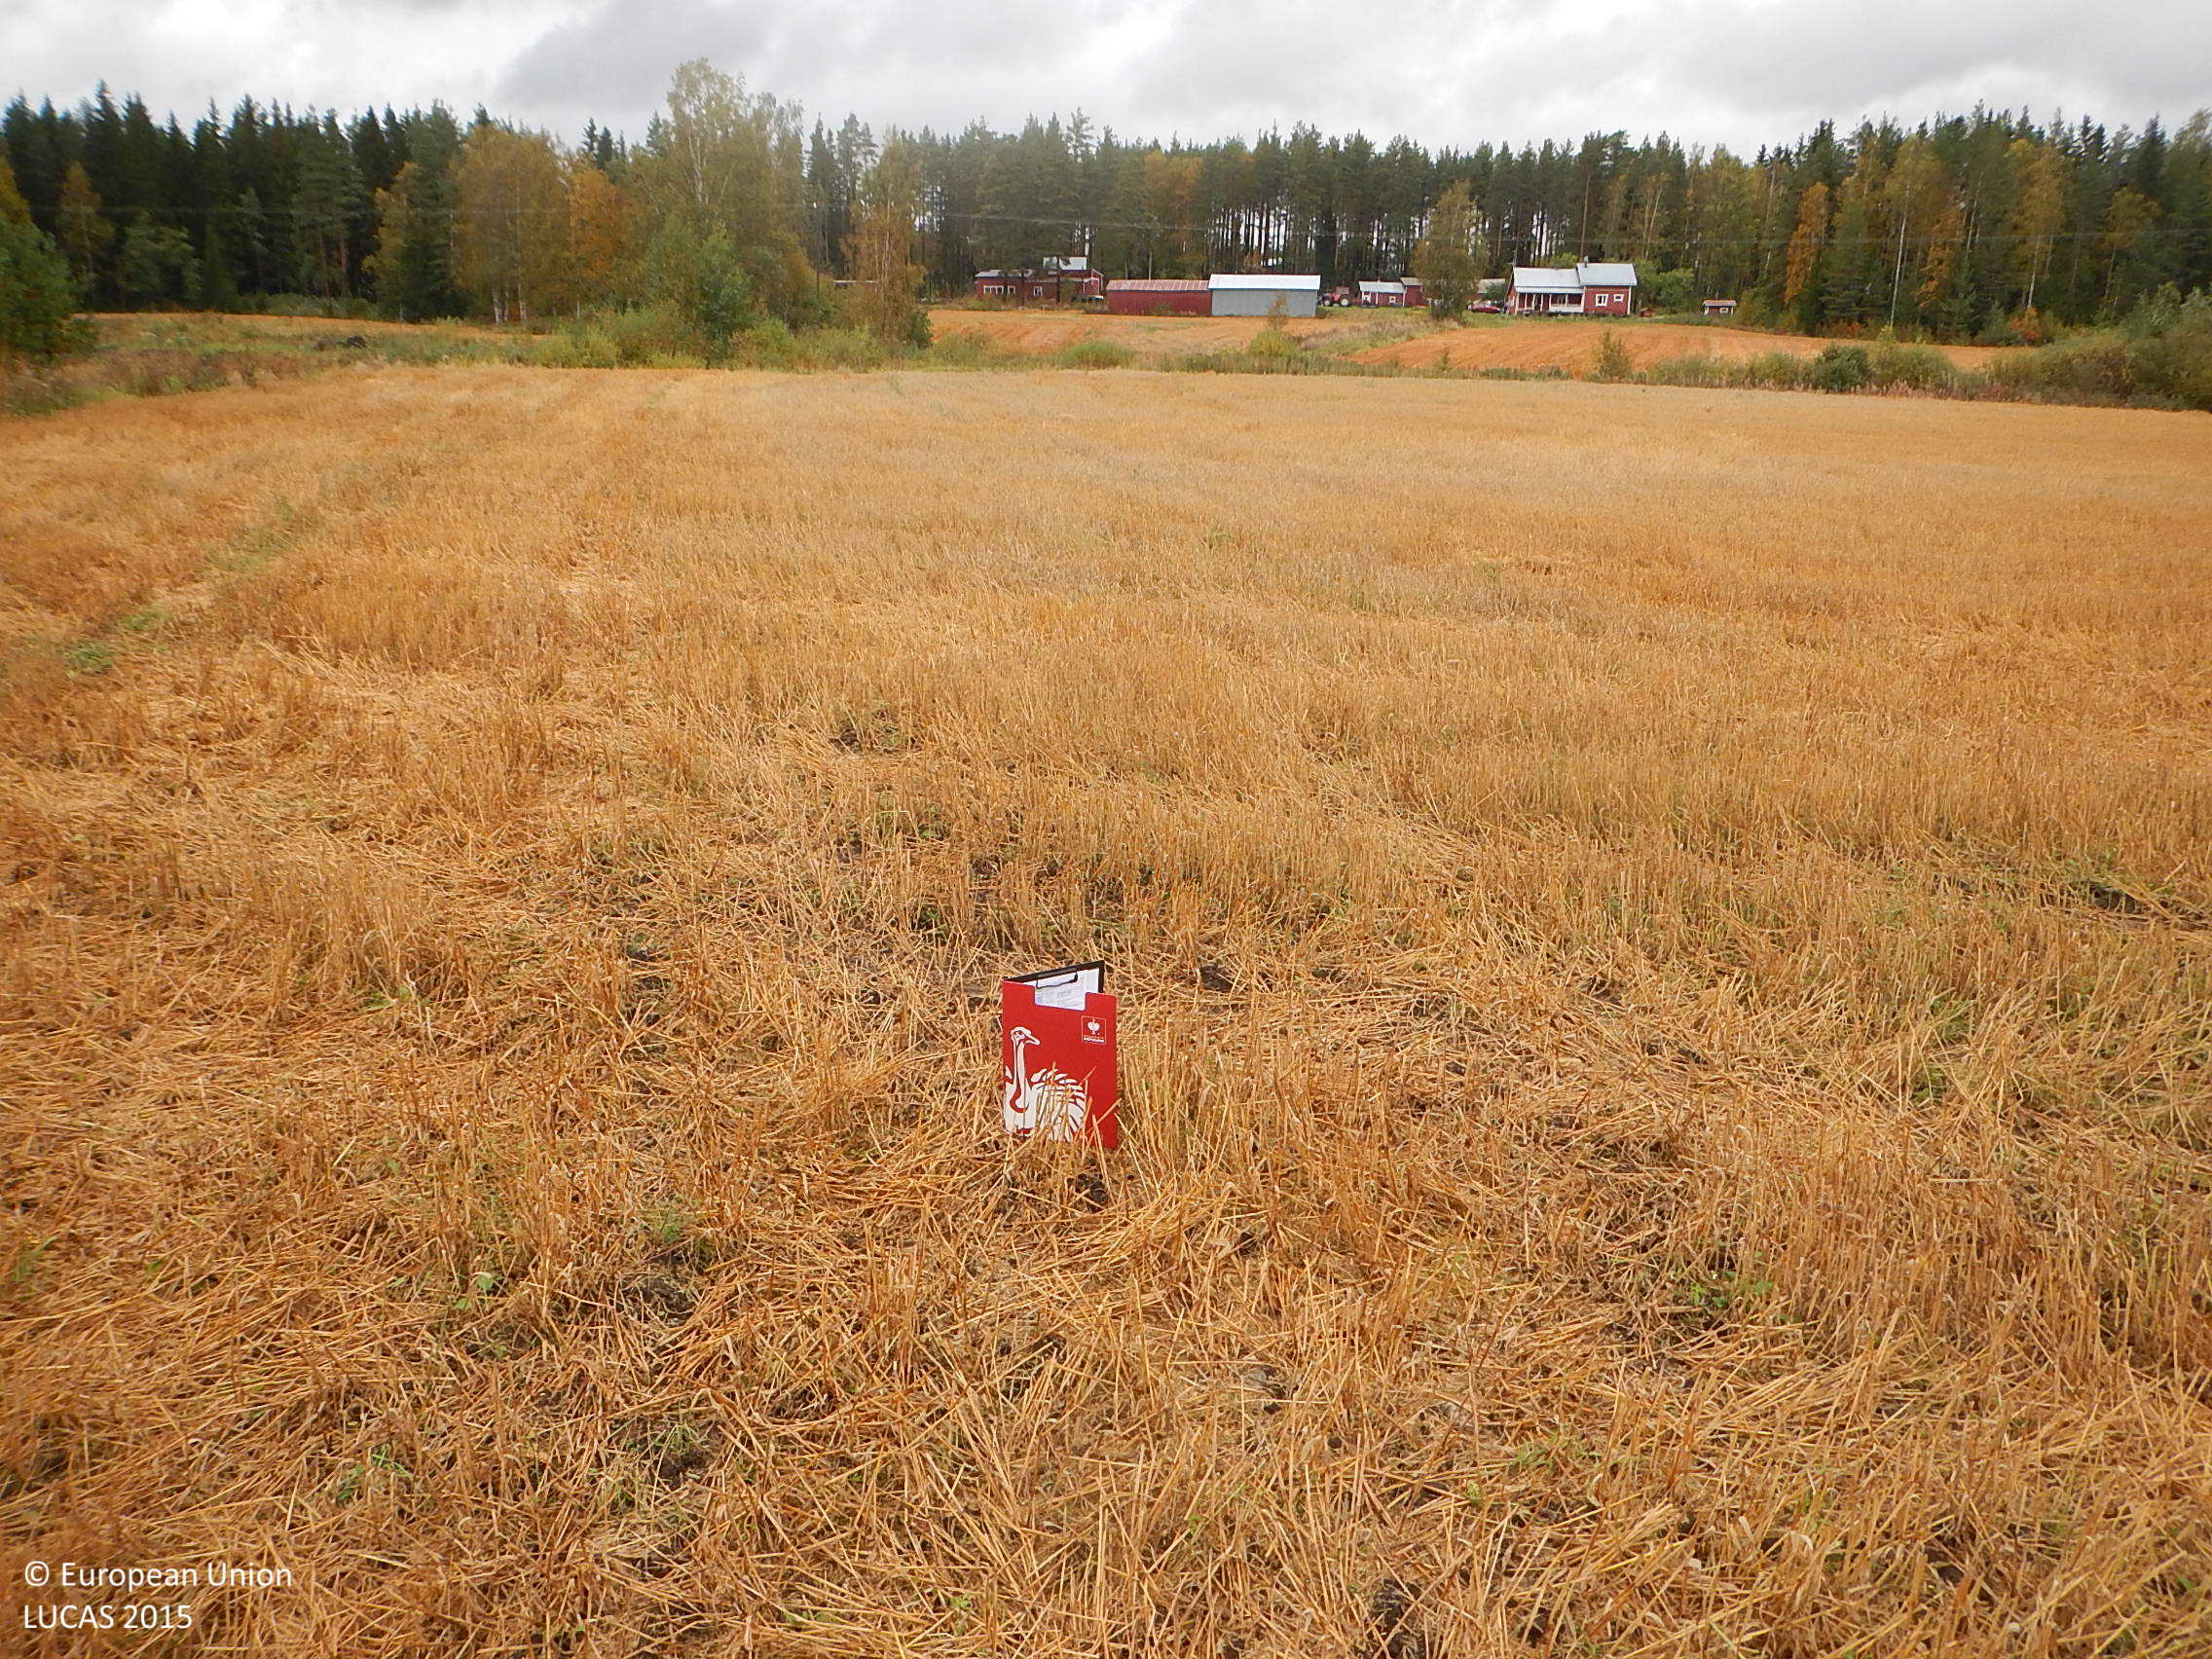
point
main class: Cropland
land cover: Barley
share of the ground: > 75 %
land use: Agriculture (excluding fallow land and kitchen gardens)
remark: Harvested field
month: September
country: FI
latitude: 61.8696
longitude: 22.2828
